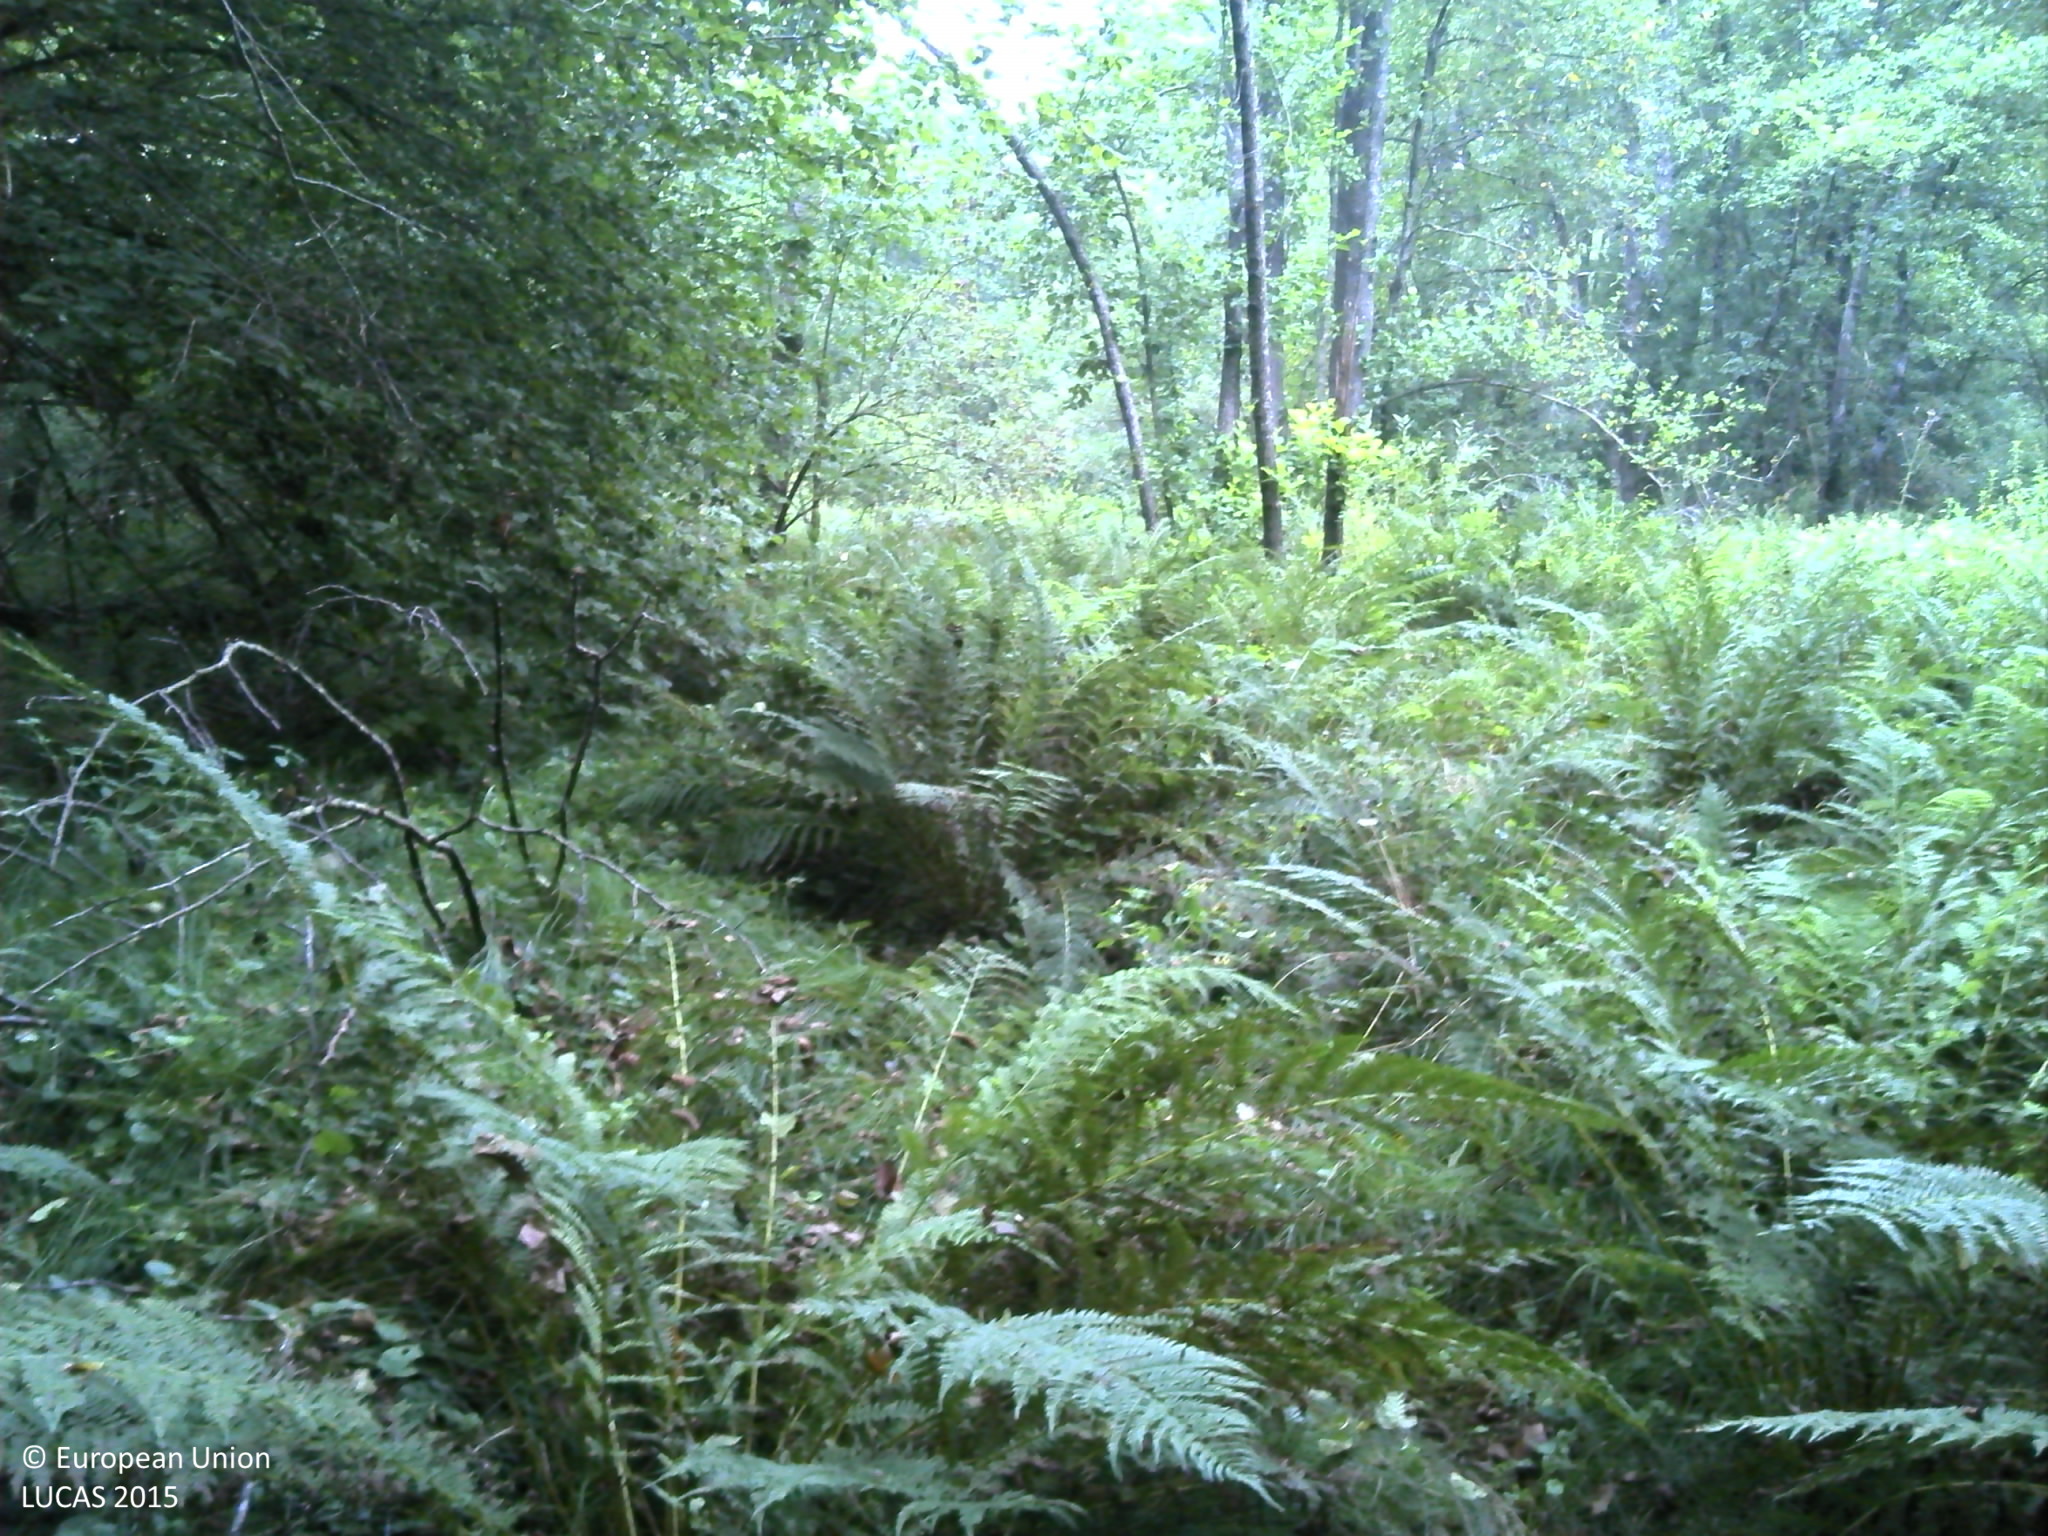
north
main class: Woodland
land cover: Broadleaved woodland
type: acidophilous oak and oak-birch forest
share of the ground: > 75 %
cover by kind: broadleaved forest trees 100 %
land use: Forestry
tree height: > 5 m
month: August
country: HR
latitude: 45.3212
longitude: 15.9030
